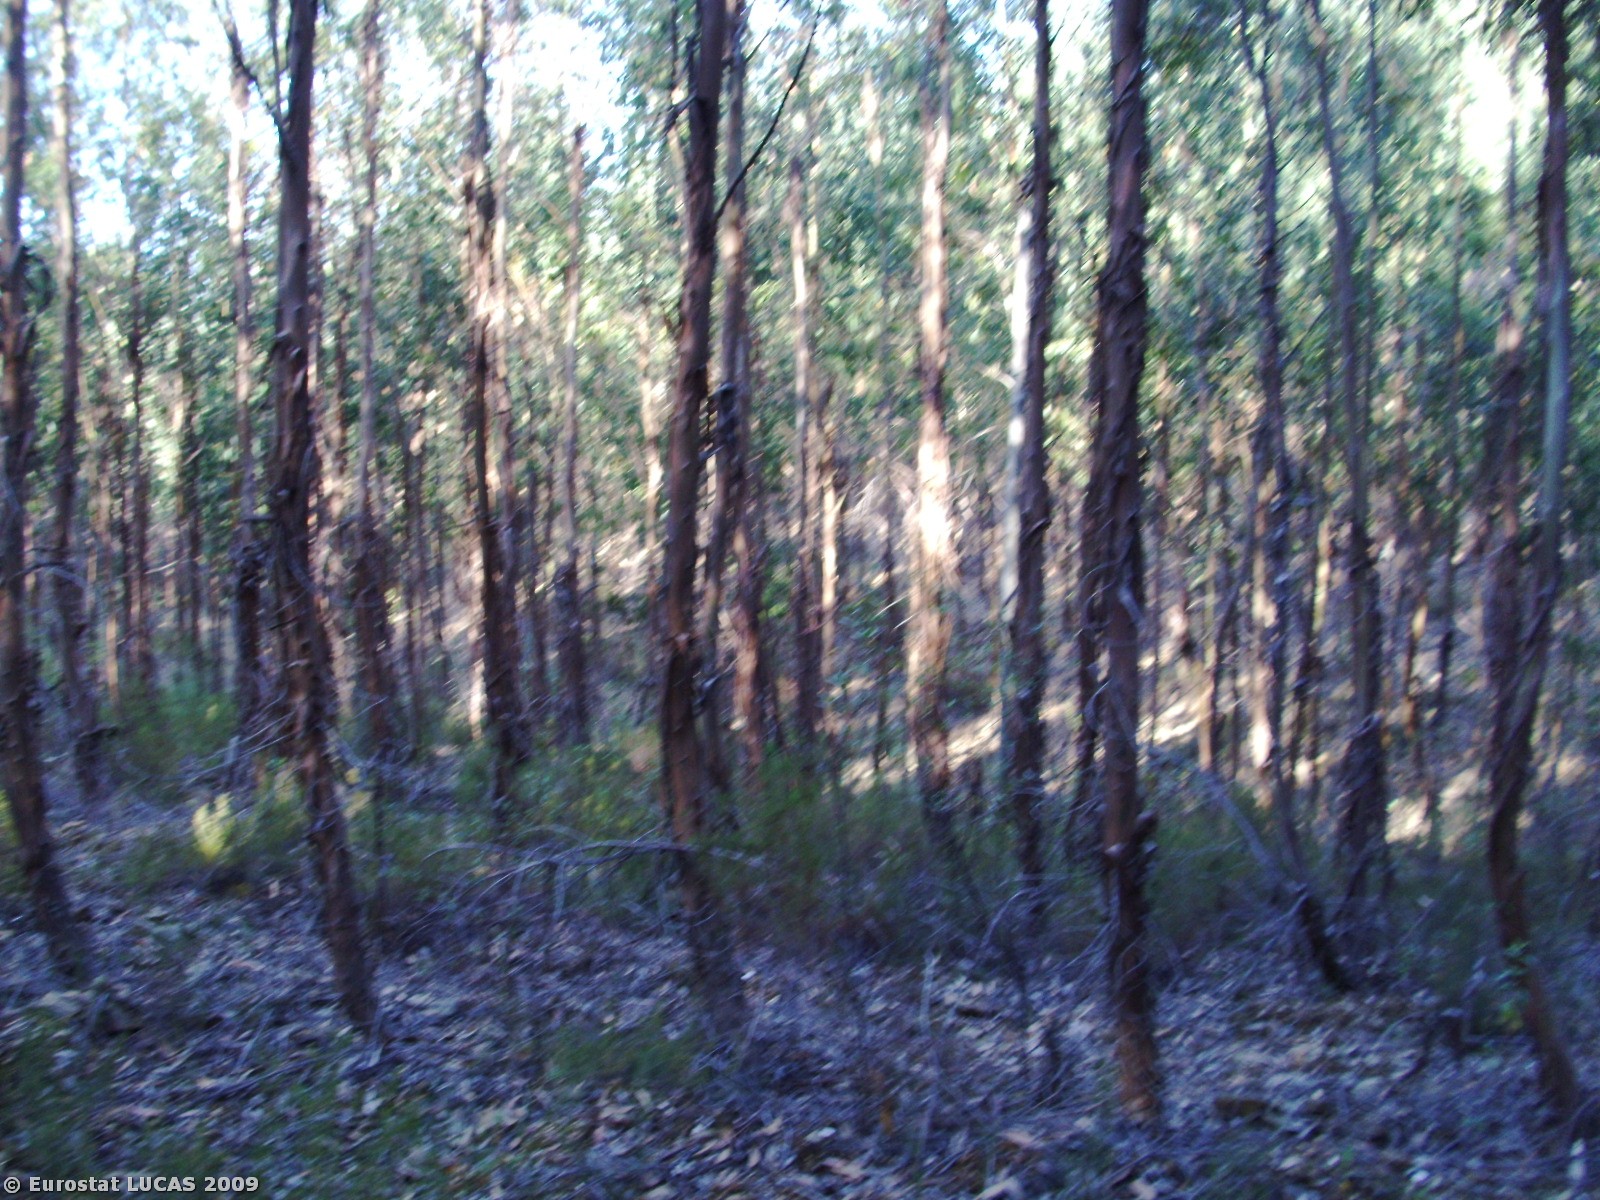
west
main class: Woodland
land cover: Broadleaved woodland
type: plantations and self-sown exotic forest
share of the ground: > 75 %
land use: Forestry
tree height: > 5 m
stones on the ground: > 50 %
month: June
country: PT
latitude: 40.0283
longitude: -7.6005
